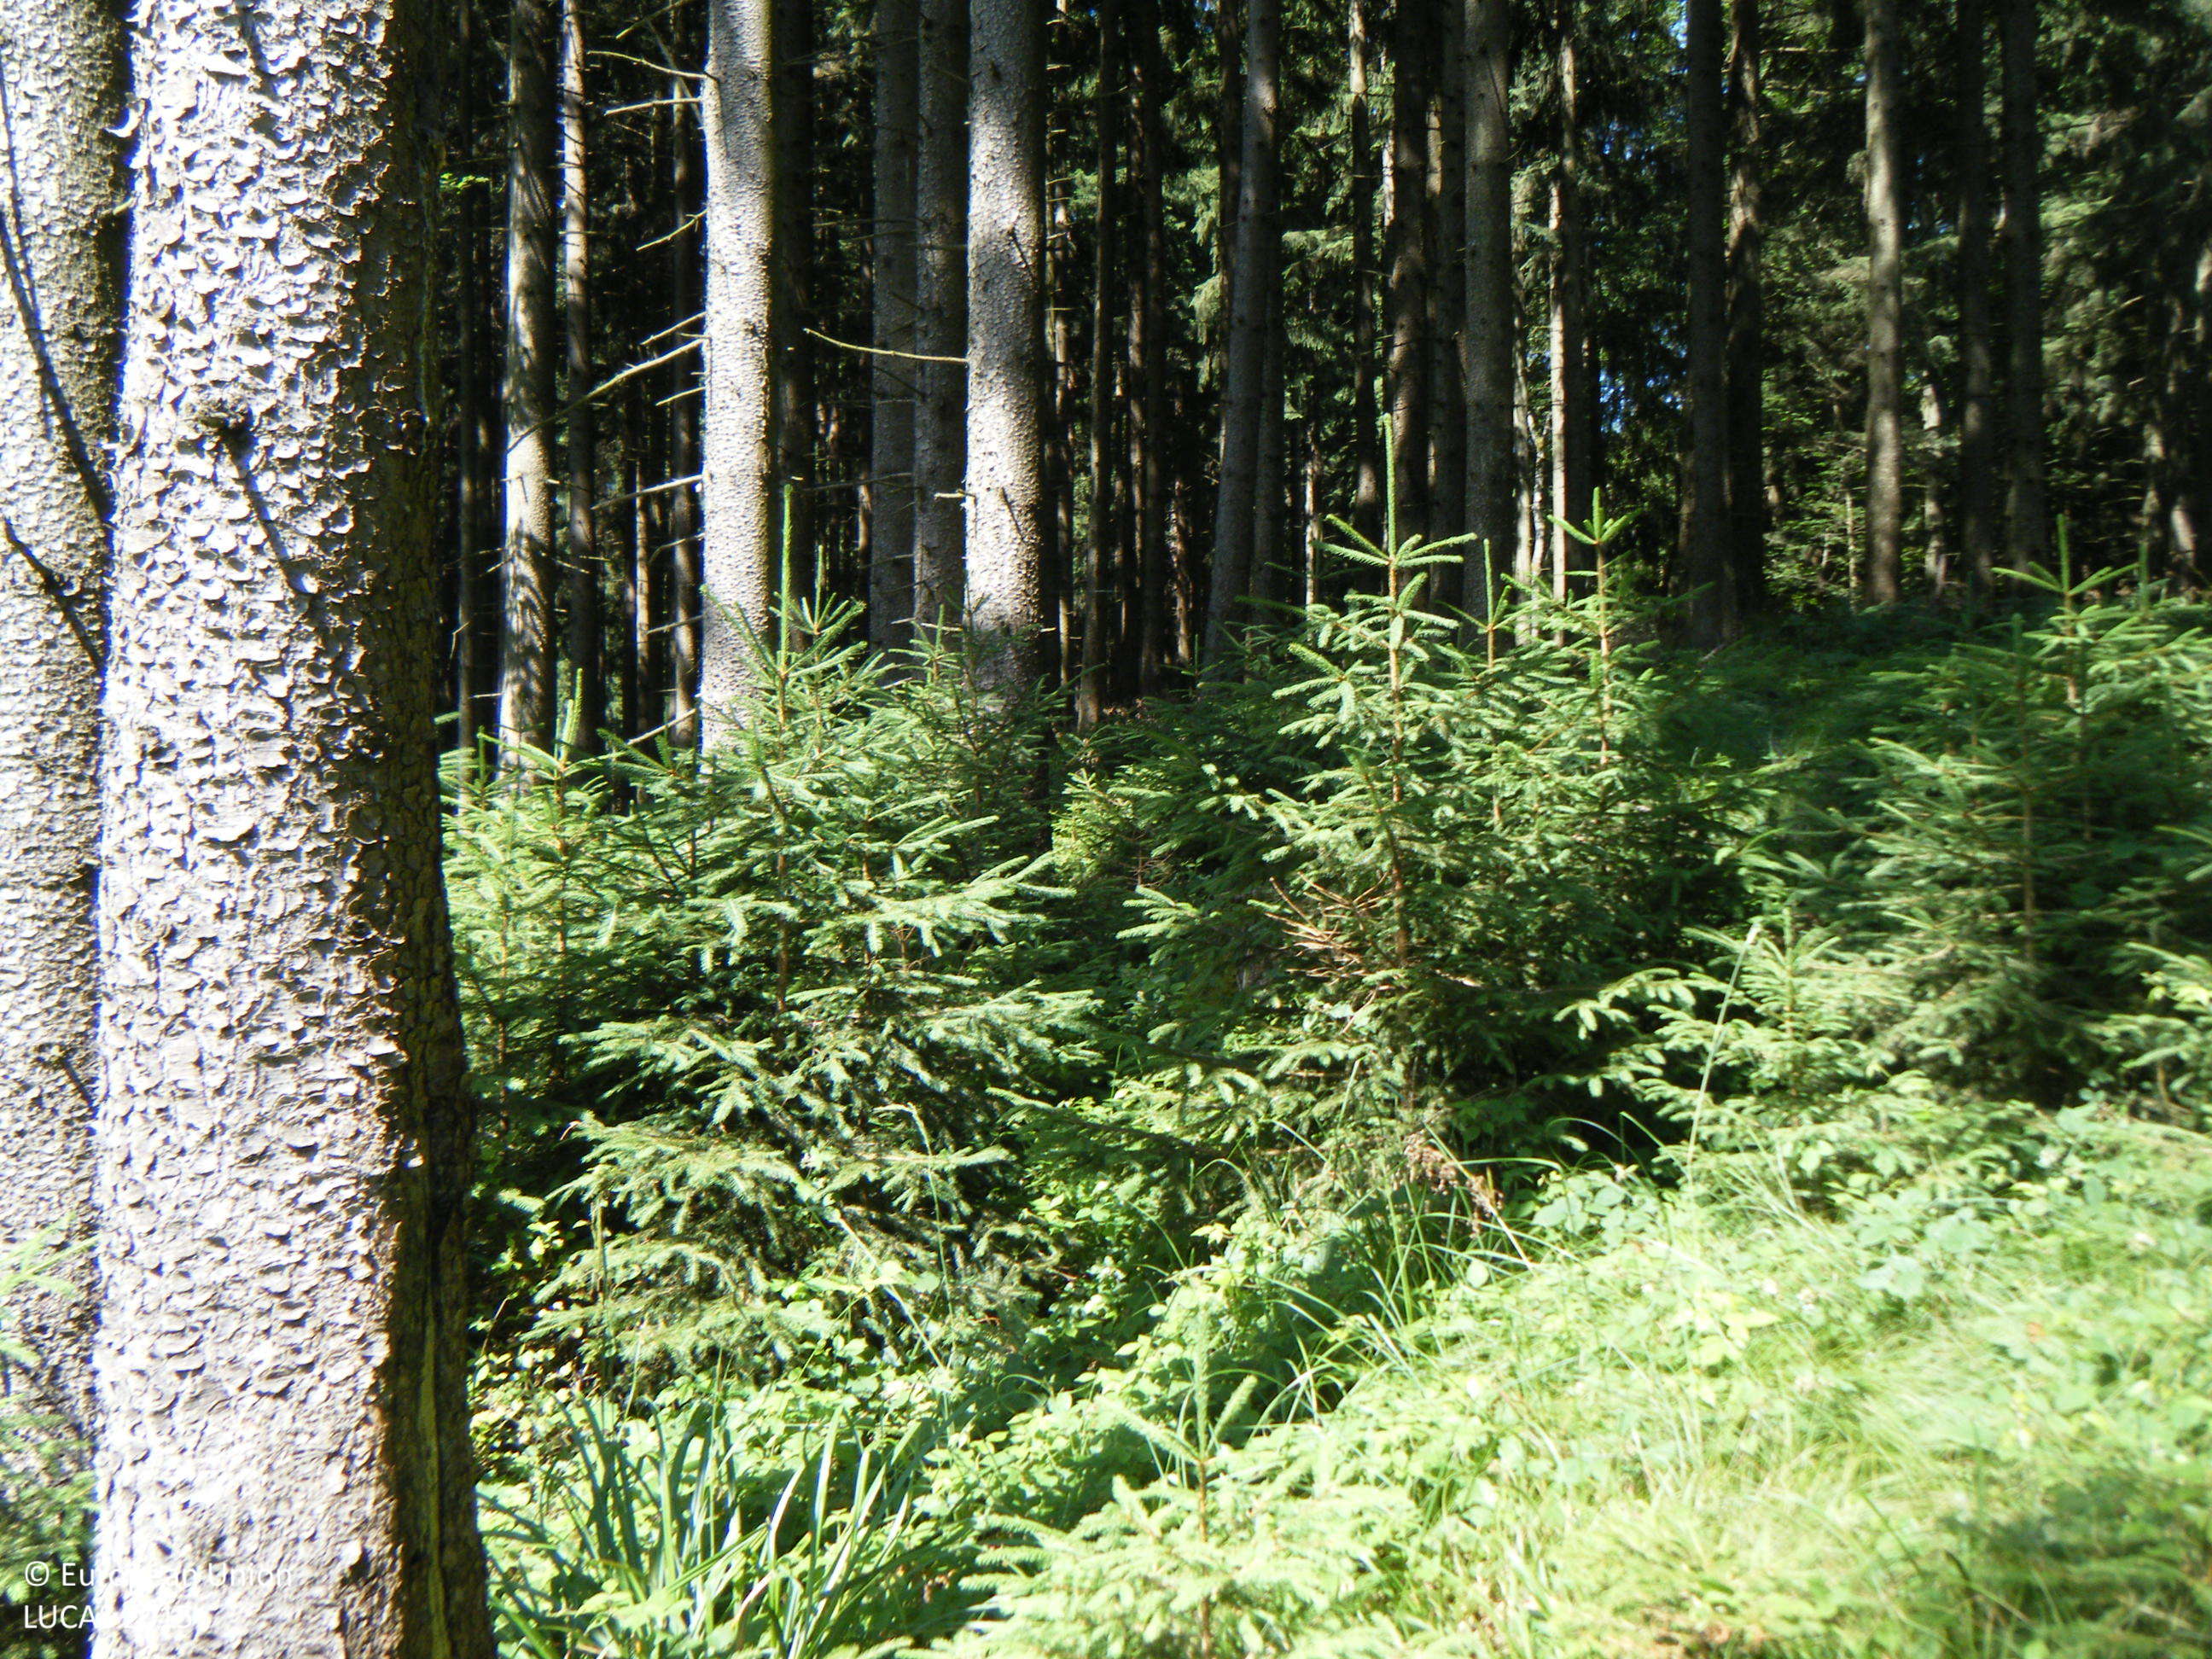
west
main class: Woodland
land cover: Spruce dominated coniferous woodland
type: alpine coniferous forest
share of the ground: > 75 %
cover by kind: coniferous forest trees 80 %, shrubs 10 %, herbaceous plants 10 %
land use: Forestry
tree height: > 5 m
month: July
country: AT
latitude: 47.8810
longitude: 13.4622
